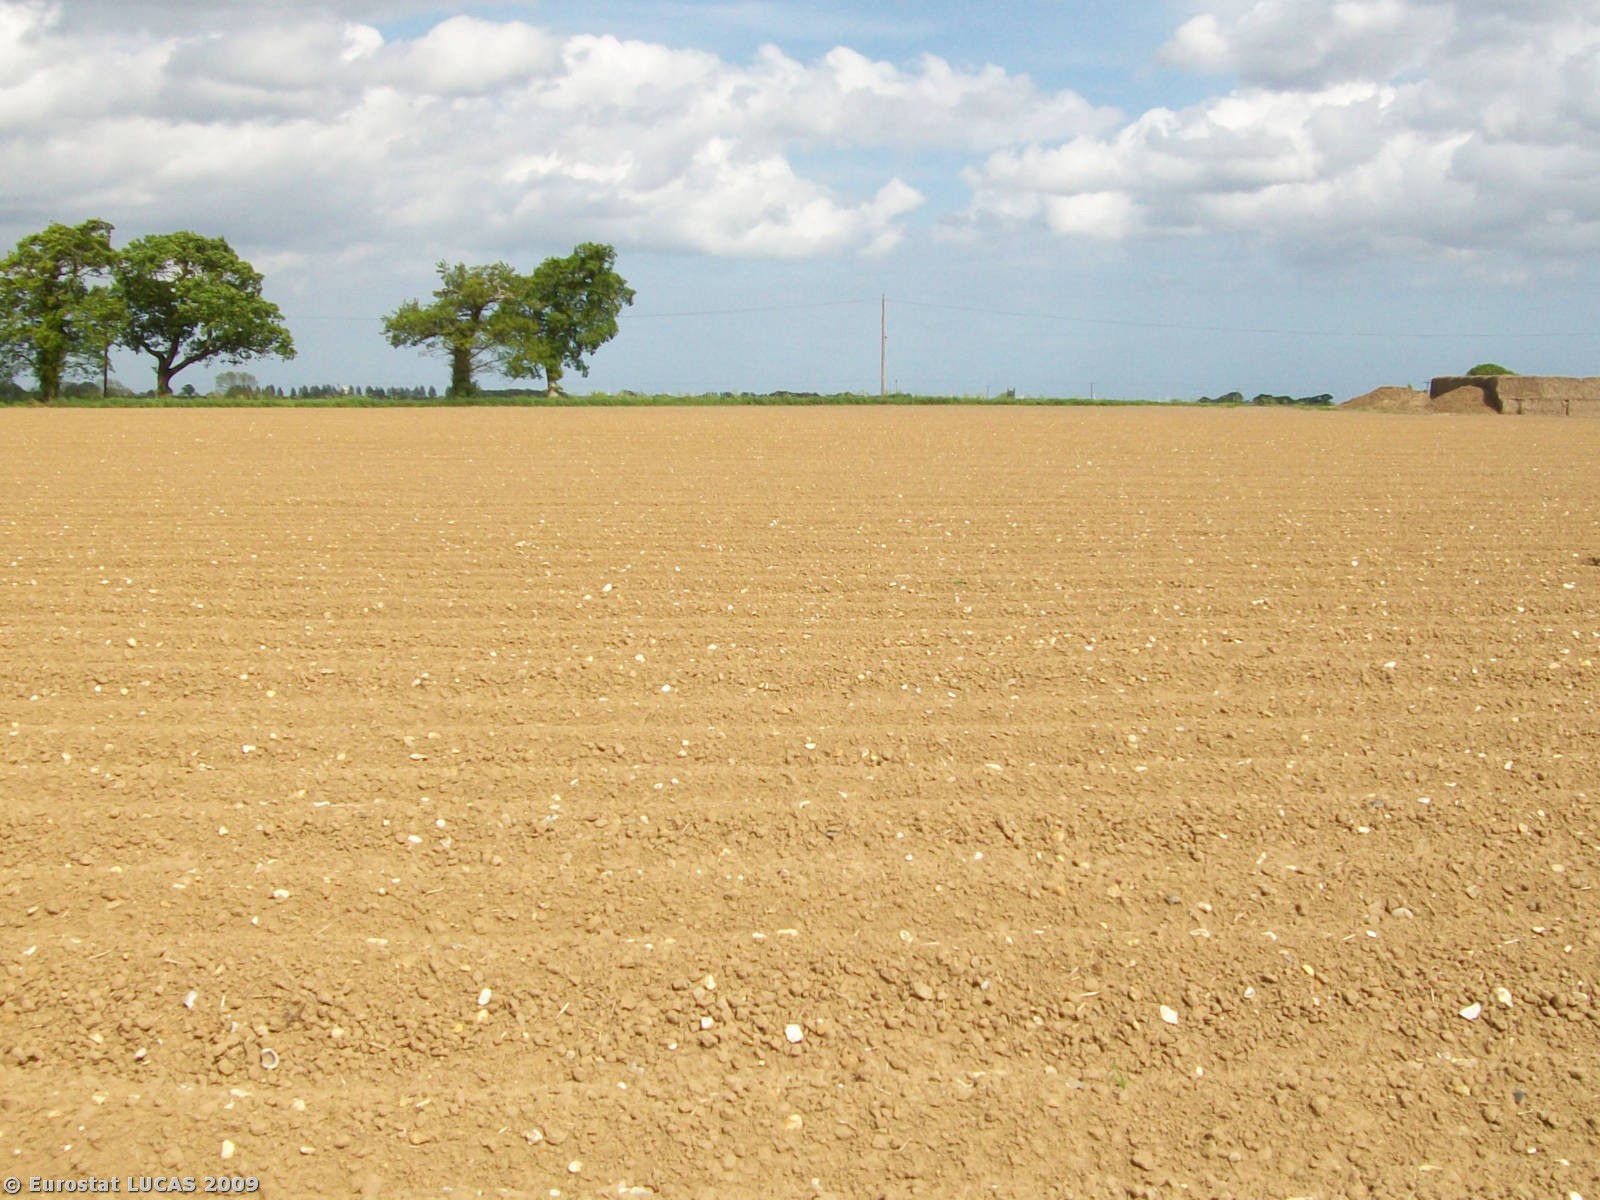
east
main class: Cropland
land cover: Barley
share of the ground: > 75 %
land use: Agriculture (excluding fallow land and kitchen gardens)
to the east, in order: Barley; Potatoes; Grass margins; Paved roads, cycling and walking lanes; Grass margins; Common wheat
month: May
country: GB
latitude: 52.6400
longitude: 1.6028
